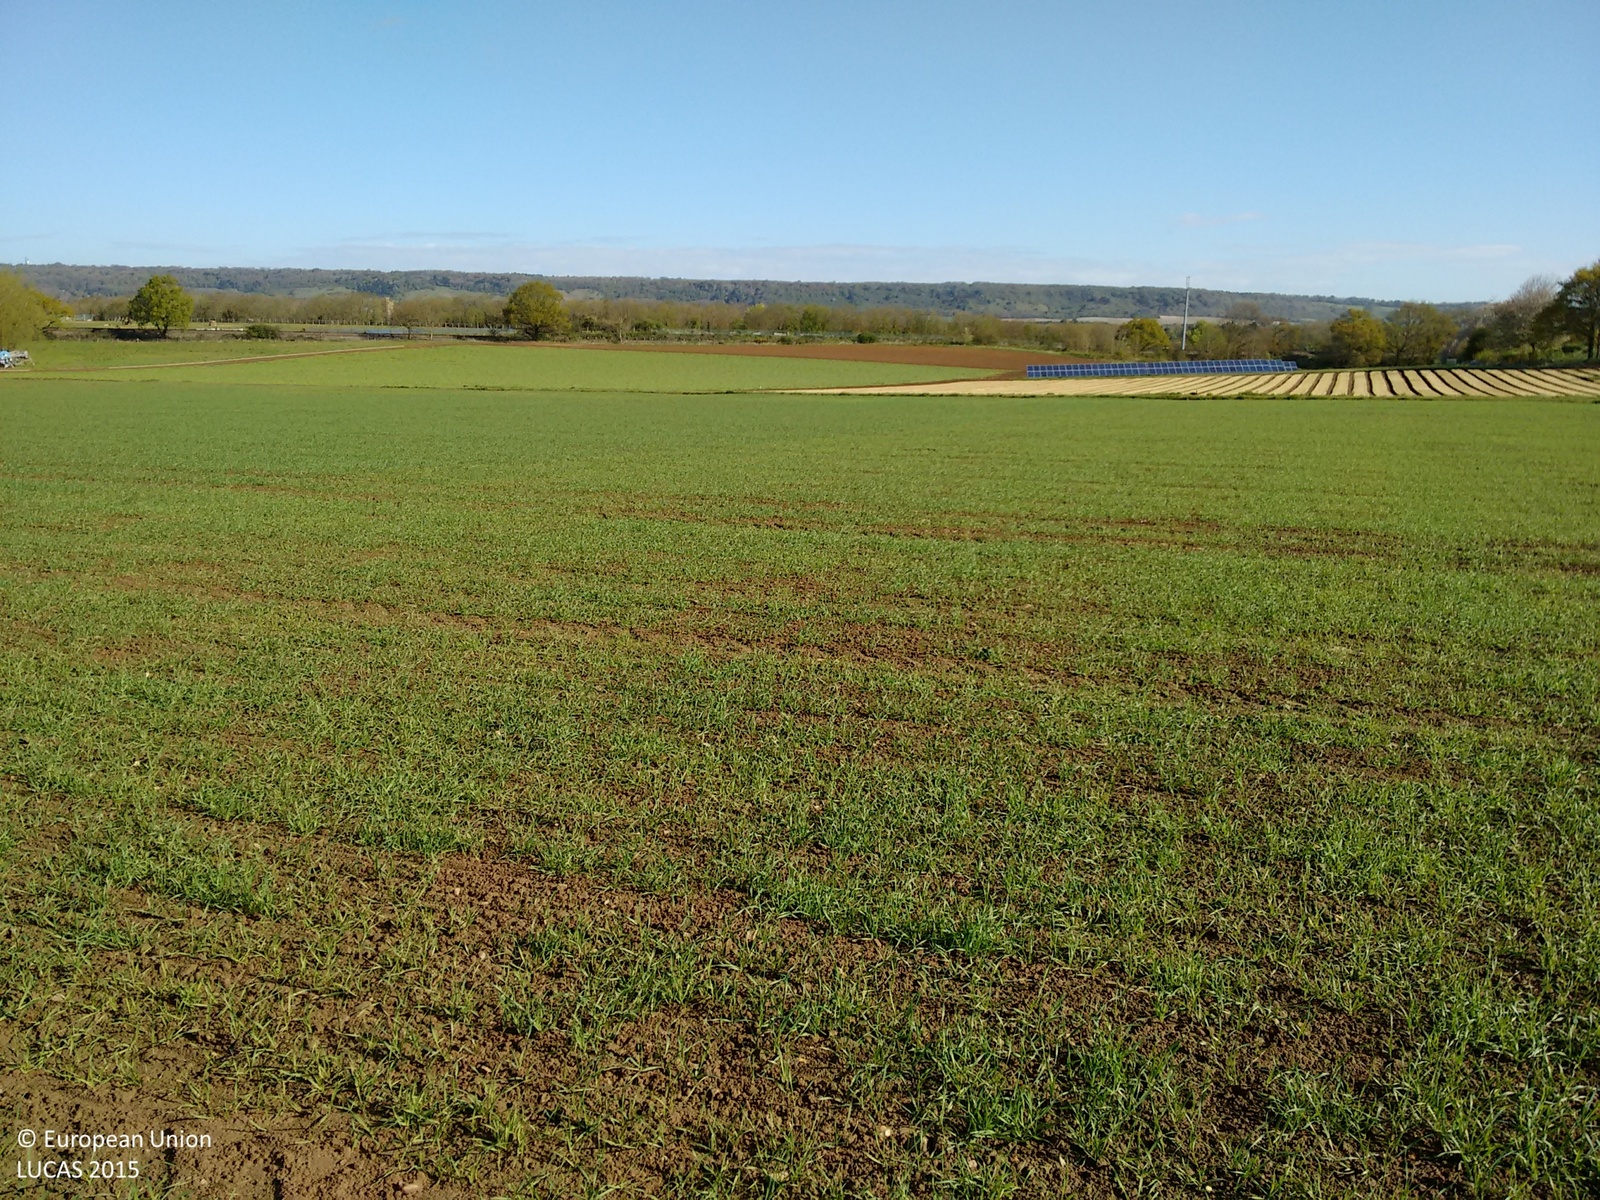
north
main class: Cropland
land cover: Common wheat
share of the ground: 25 - 50 %
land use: Agriculture (excluding fallow land and kitchen gardens)
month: April
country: GB
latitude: 51.2975
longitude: 0.3762
